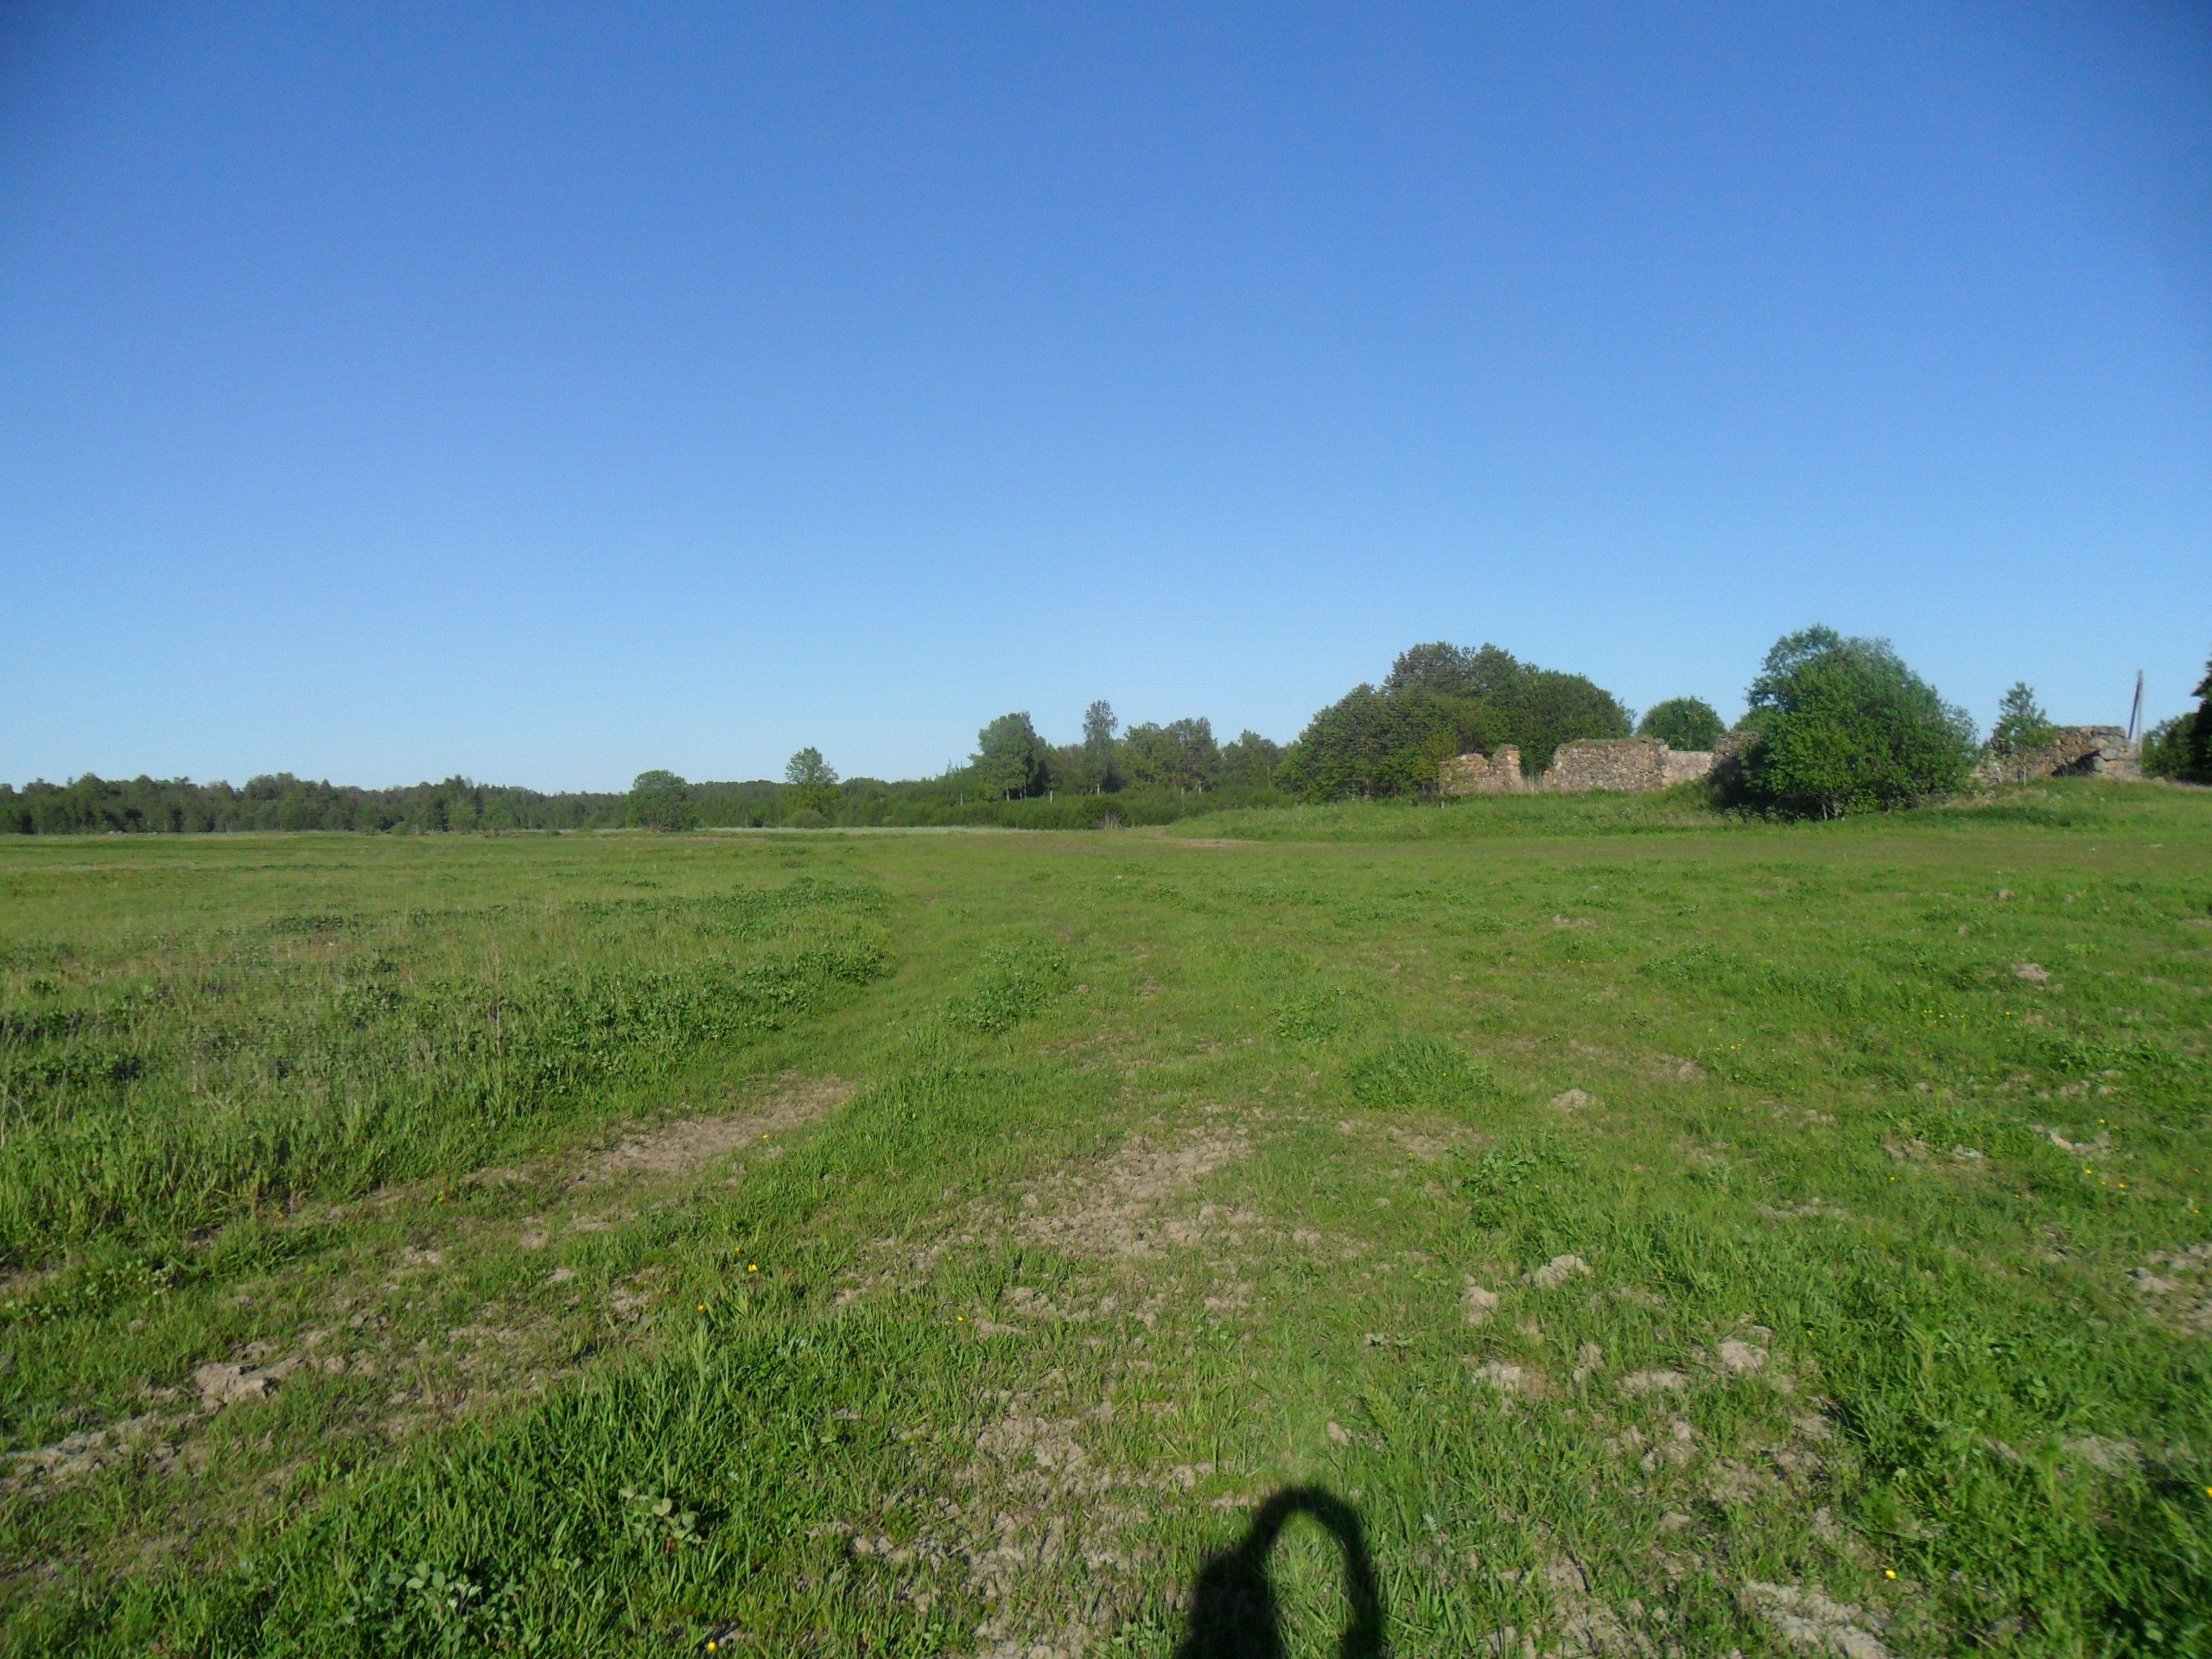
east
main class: Grassland
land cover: Grassland without tree/shrub cover
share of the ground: > 75 %
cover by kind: herbaceous plants 85 %, unconsolidated bare surface 5 %
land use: Agriculture (excluding fallow land and kitchen gardens)
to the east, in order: Grassland without tree/shrub cover; Paved roads, cycling and walking lanes; Grassland without tree/shrub cover
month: June
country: LV
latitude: 57.5752
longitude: 22.3402
